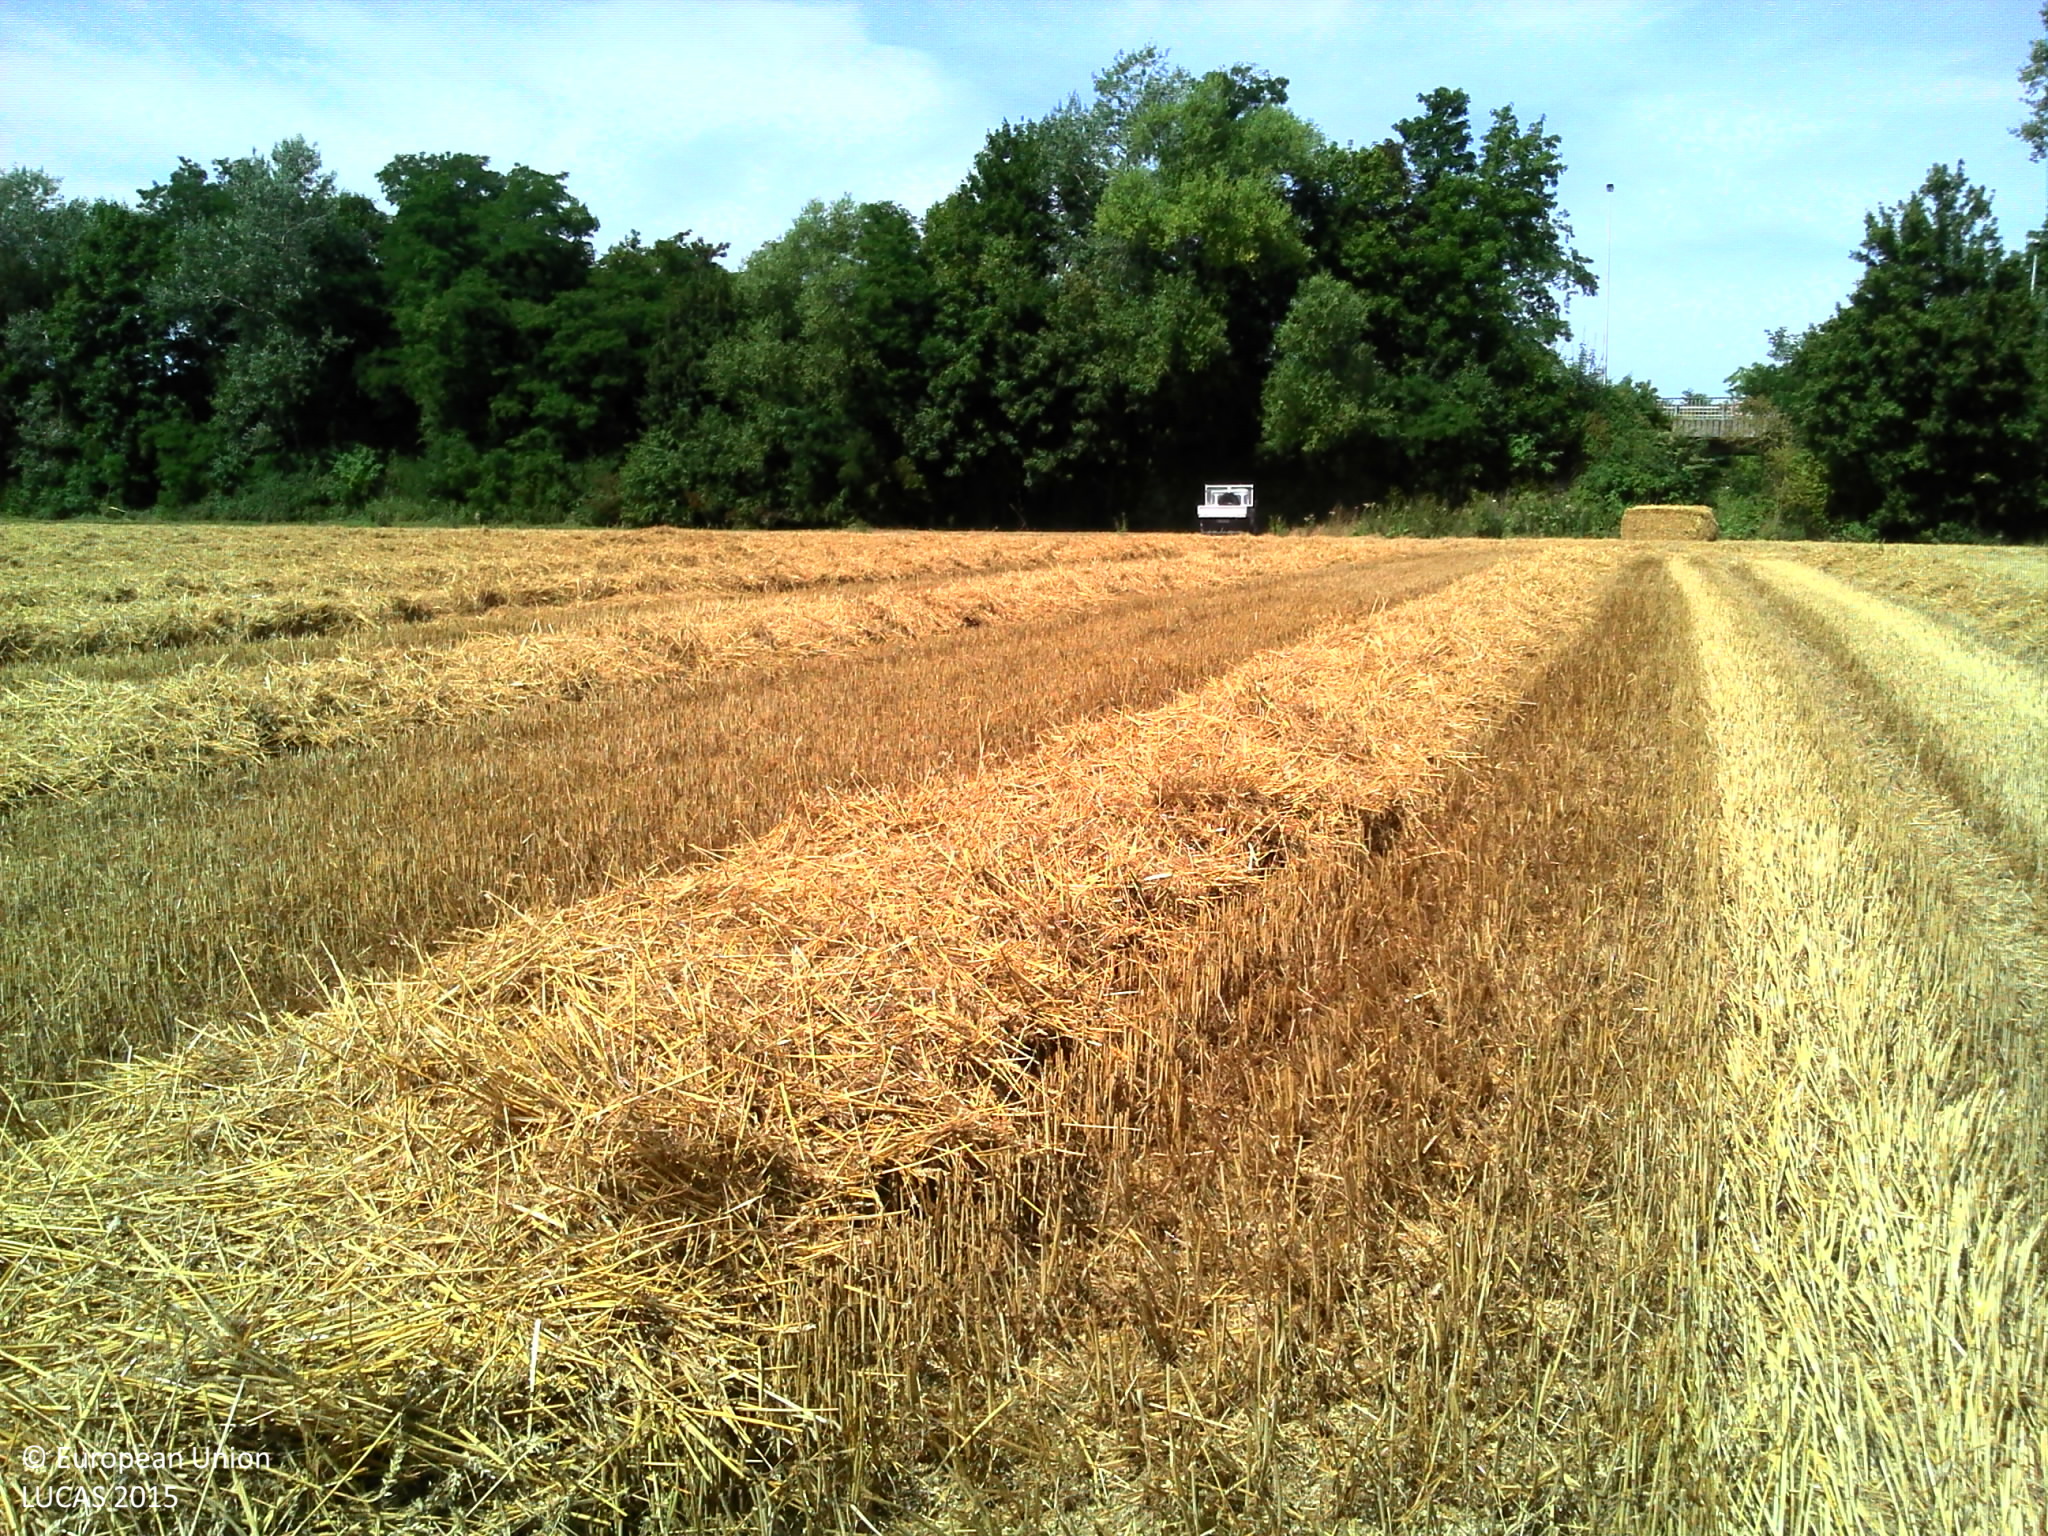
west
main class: Cropland
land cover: Common wheat
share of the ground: 10 - 25 %
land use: Agriculture (excluding fallow land and kitchen gardens)
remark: Harvested field
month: August
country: FR
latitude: 50.3356
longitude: 3.0922
